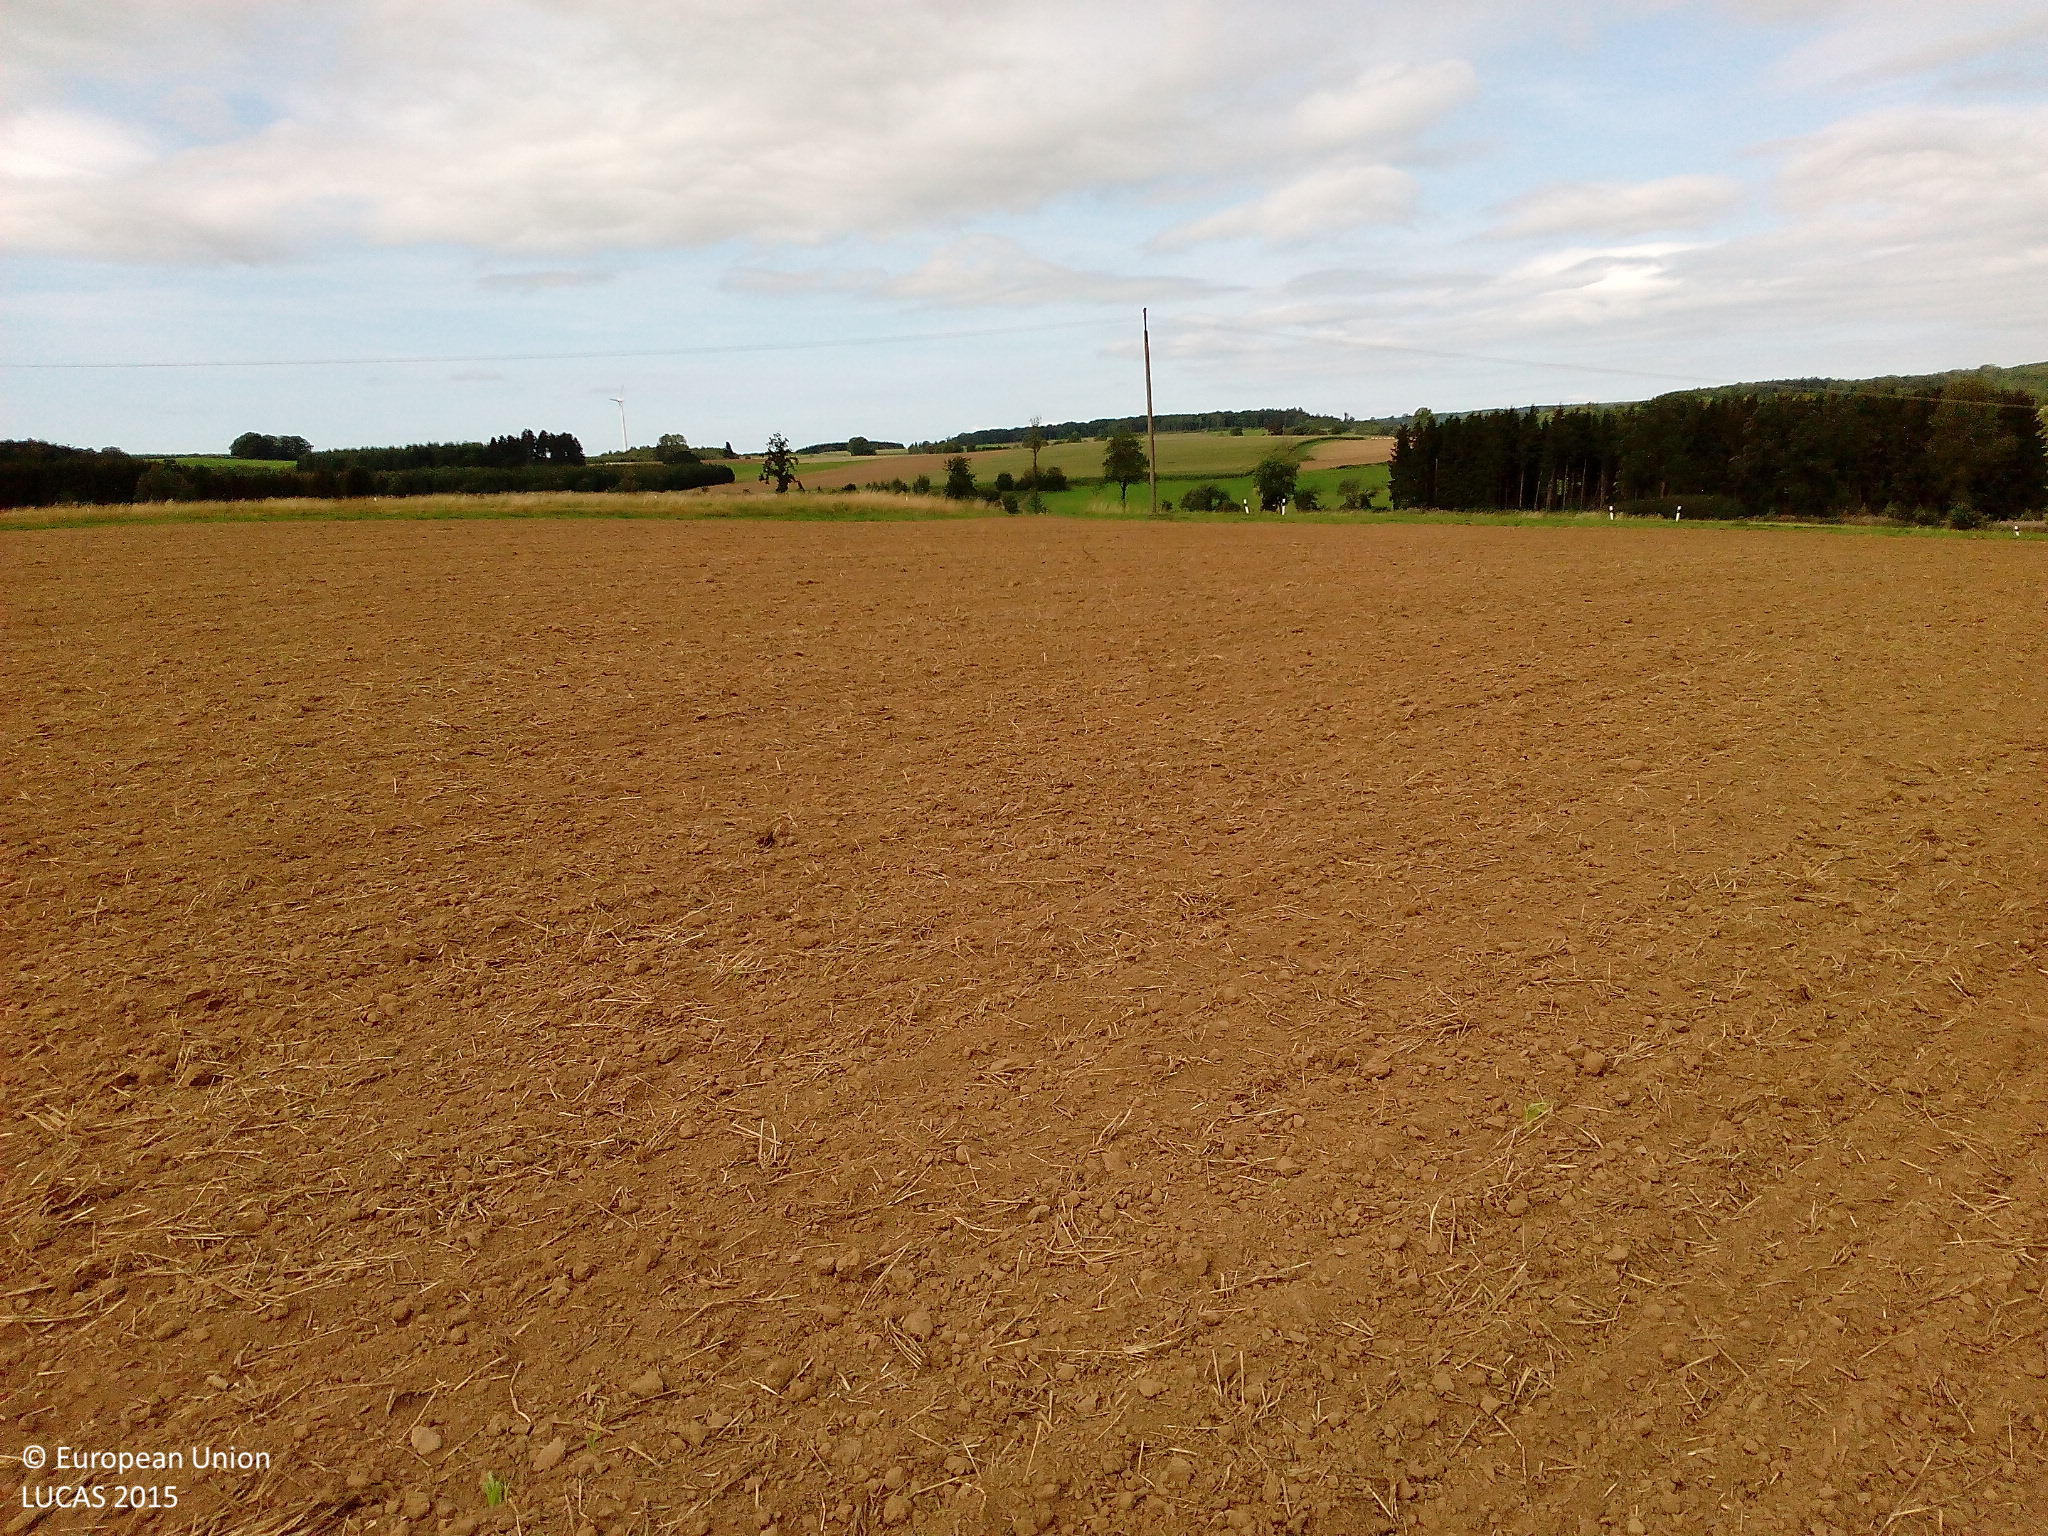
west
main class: Cropland
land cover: Rye
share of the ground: < 10 %
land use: Agriculture (excluding fallow land and kitchen gardens)
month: August
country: DE
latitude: 50.4161
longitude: 9.3388
